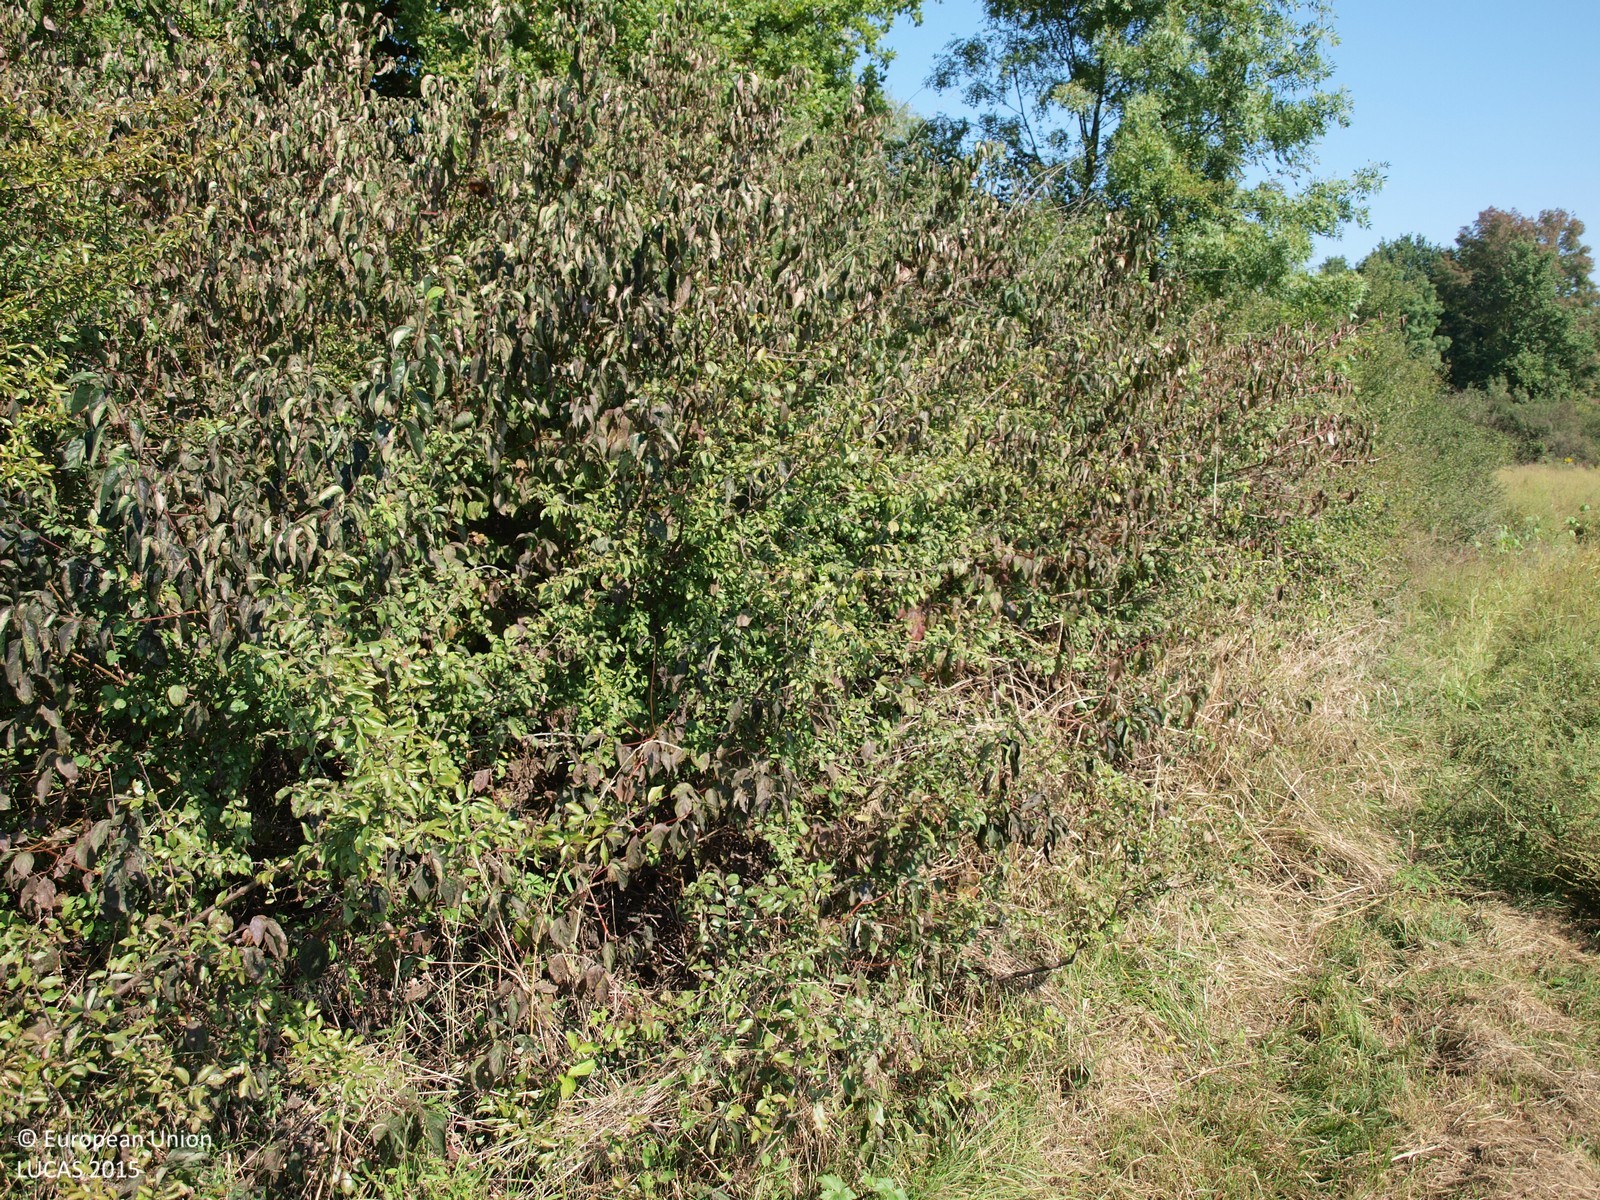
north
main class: Grassland
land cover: Grassland without tree/shrub cover
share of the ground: > 75 %
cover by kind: herbaceous plants 100 %
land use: Agriculture (excluding fallow land and kitchen gardens)
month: September
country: HR
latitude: 45.6432
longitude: 16.2720
